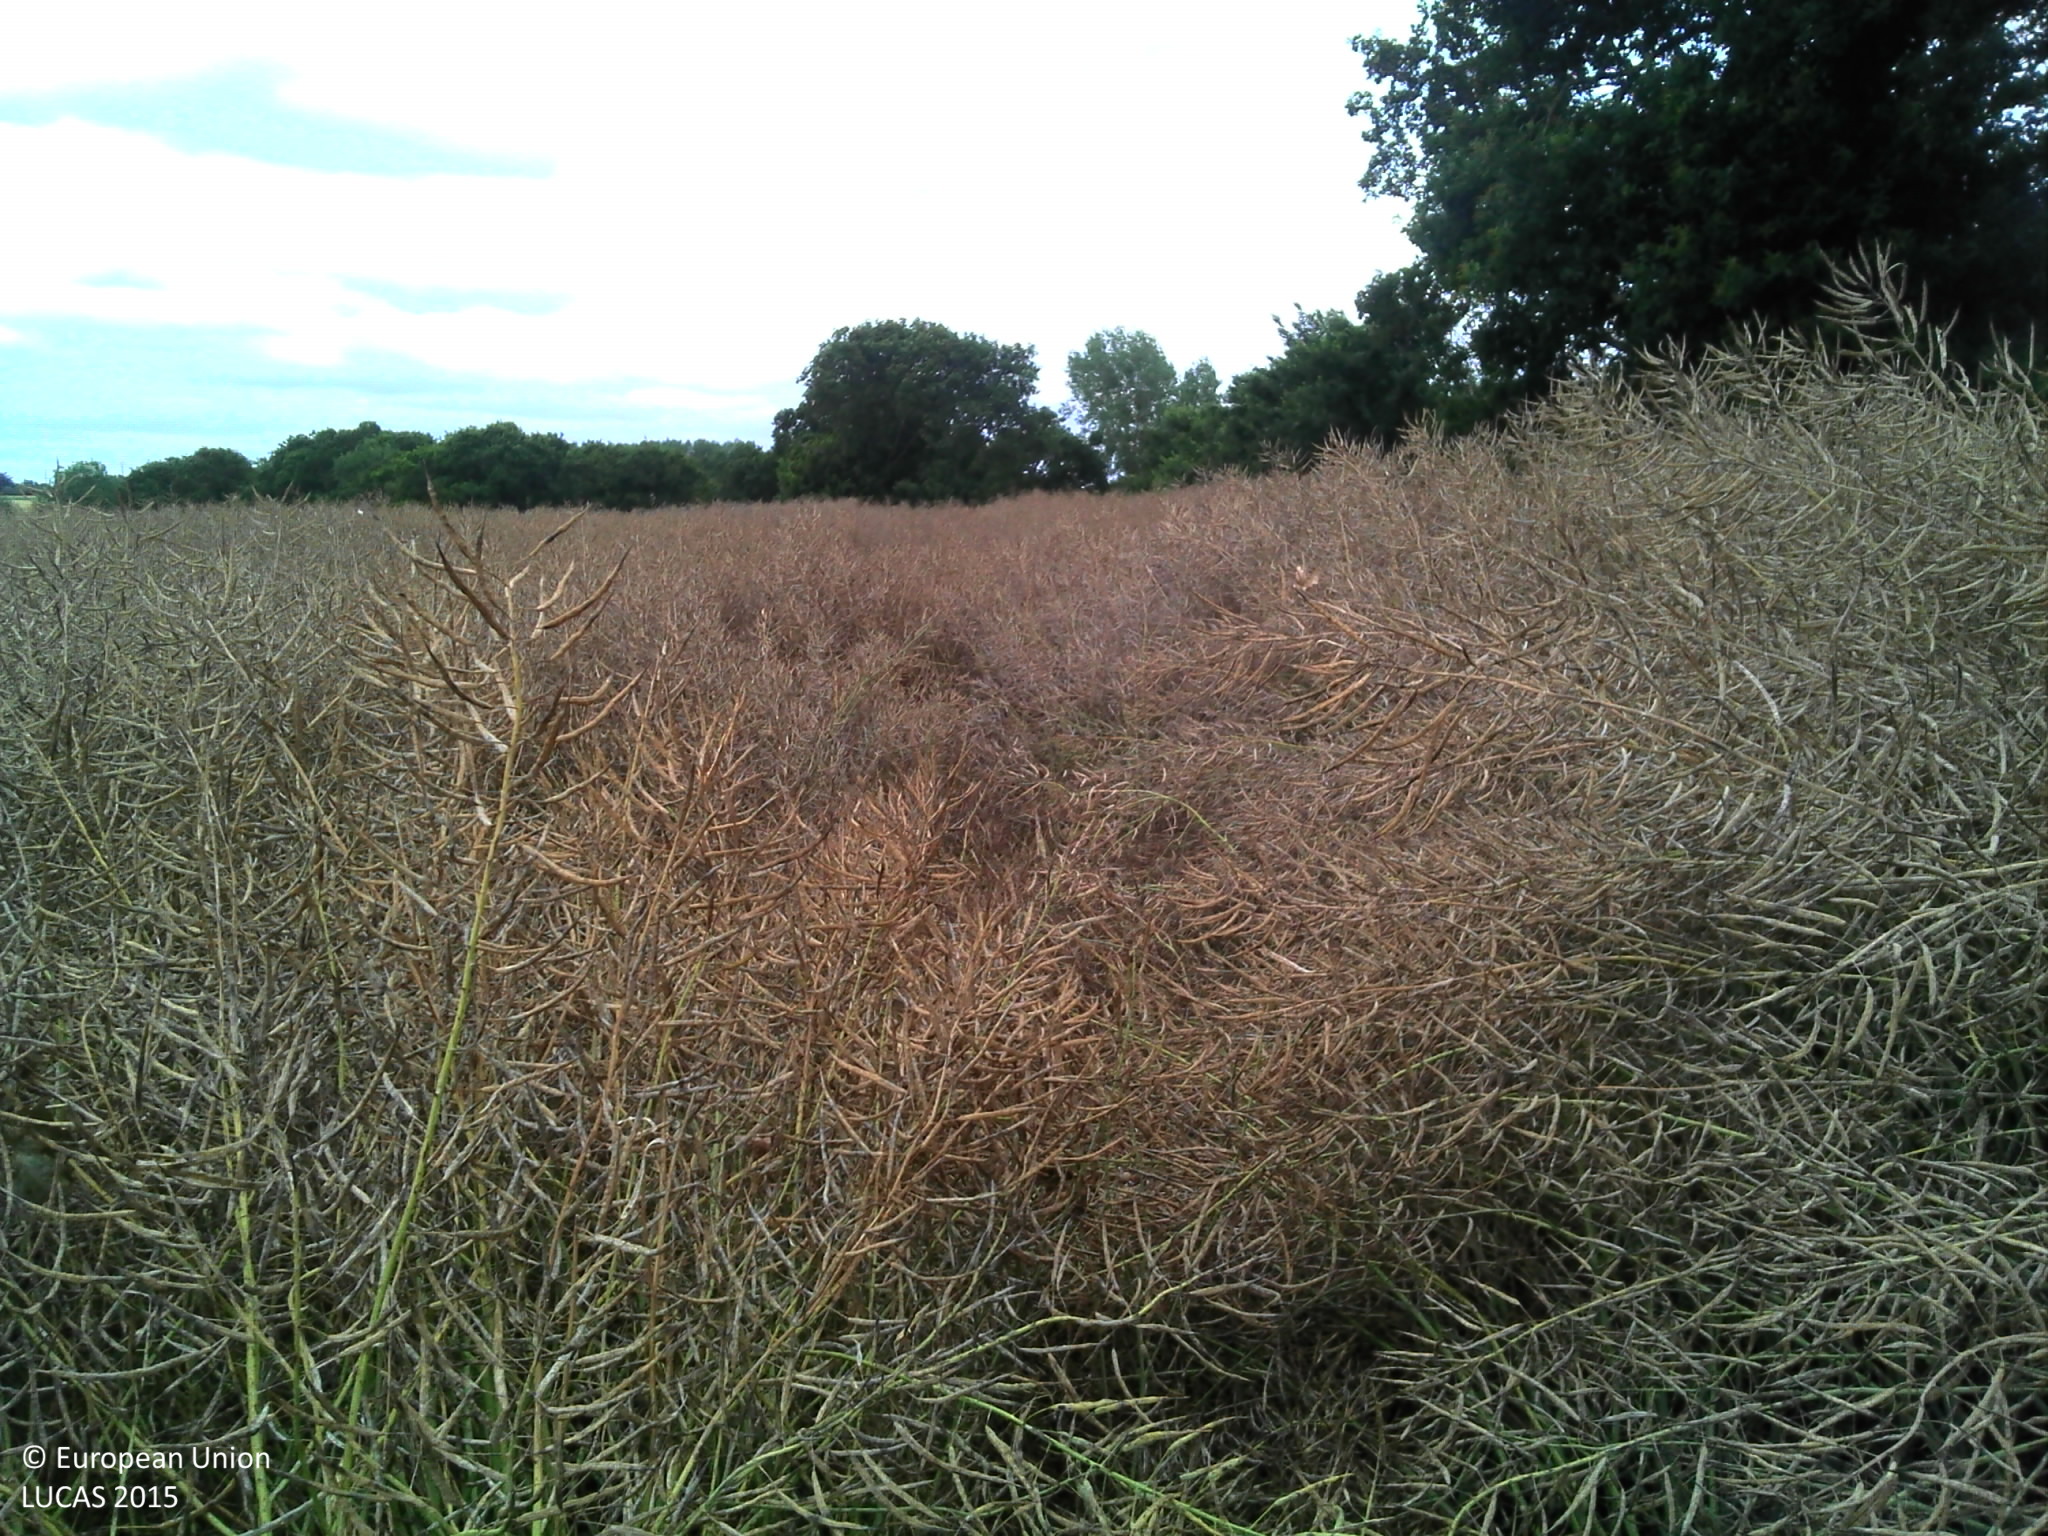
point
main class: Cropland
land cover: Rape and turnip rape
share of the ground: > 75 %
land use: Agriculture (excluding fallow land and kitchen gardens)
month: July
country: FR
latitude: 48.6075
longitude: -2.4436
